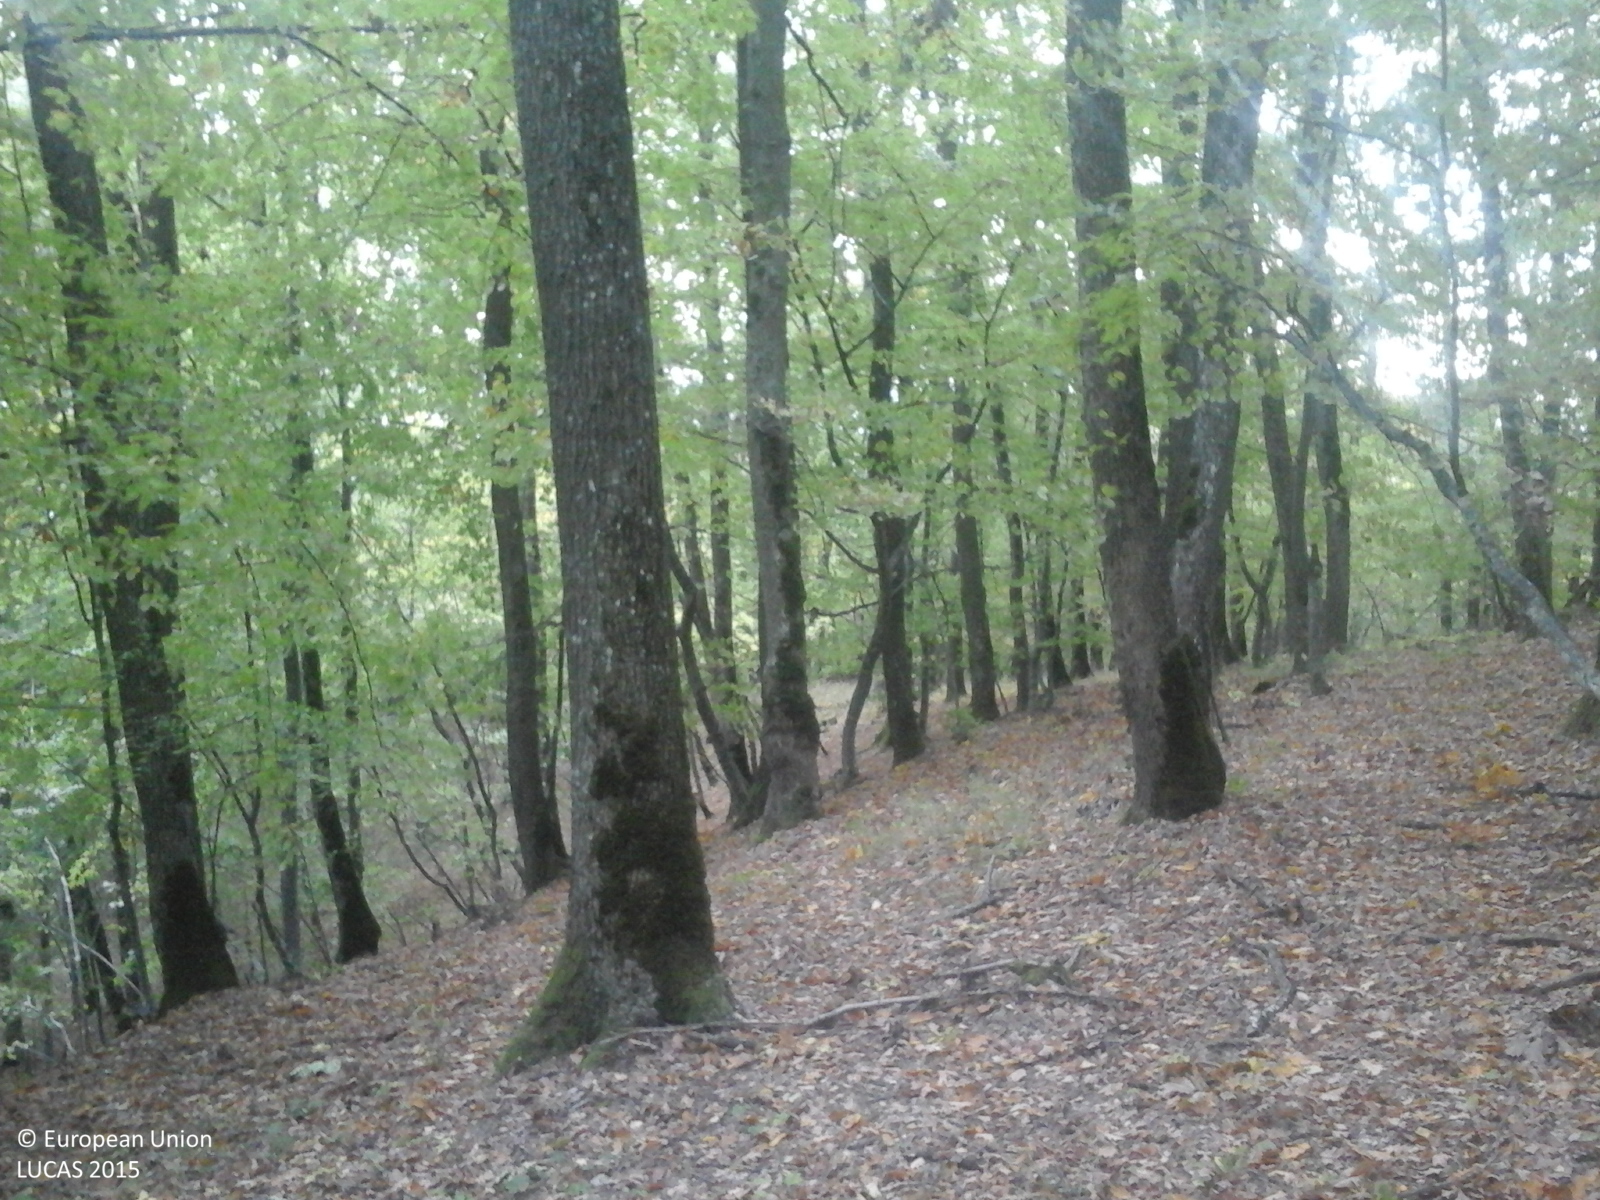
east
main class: Woodland
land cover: Broadleaved woodland
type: acidophilous oak and oak-birch forest
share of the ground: > 75 %
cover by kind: broadleaved forest trees 100 %
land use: Forestry
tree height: > 5 m
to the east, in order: Broadleaved woodland
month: October
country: RO
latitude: 46.1632
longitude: 25.2660
